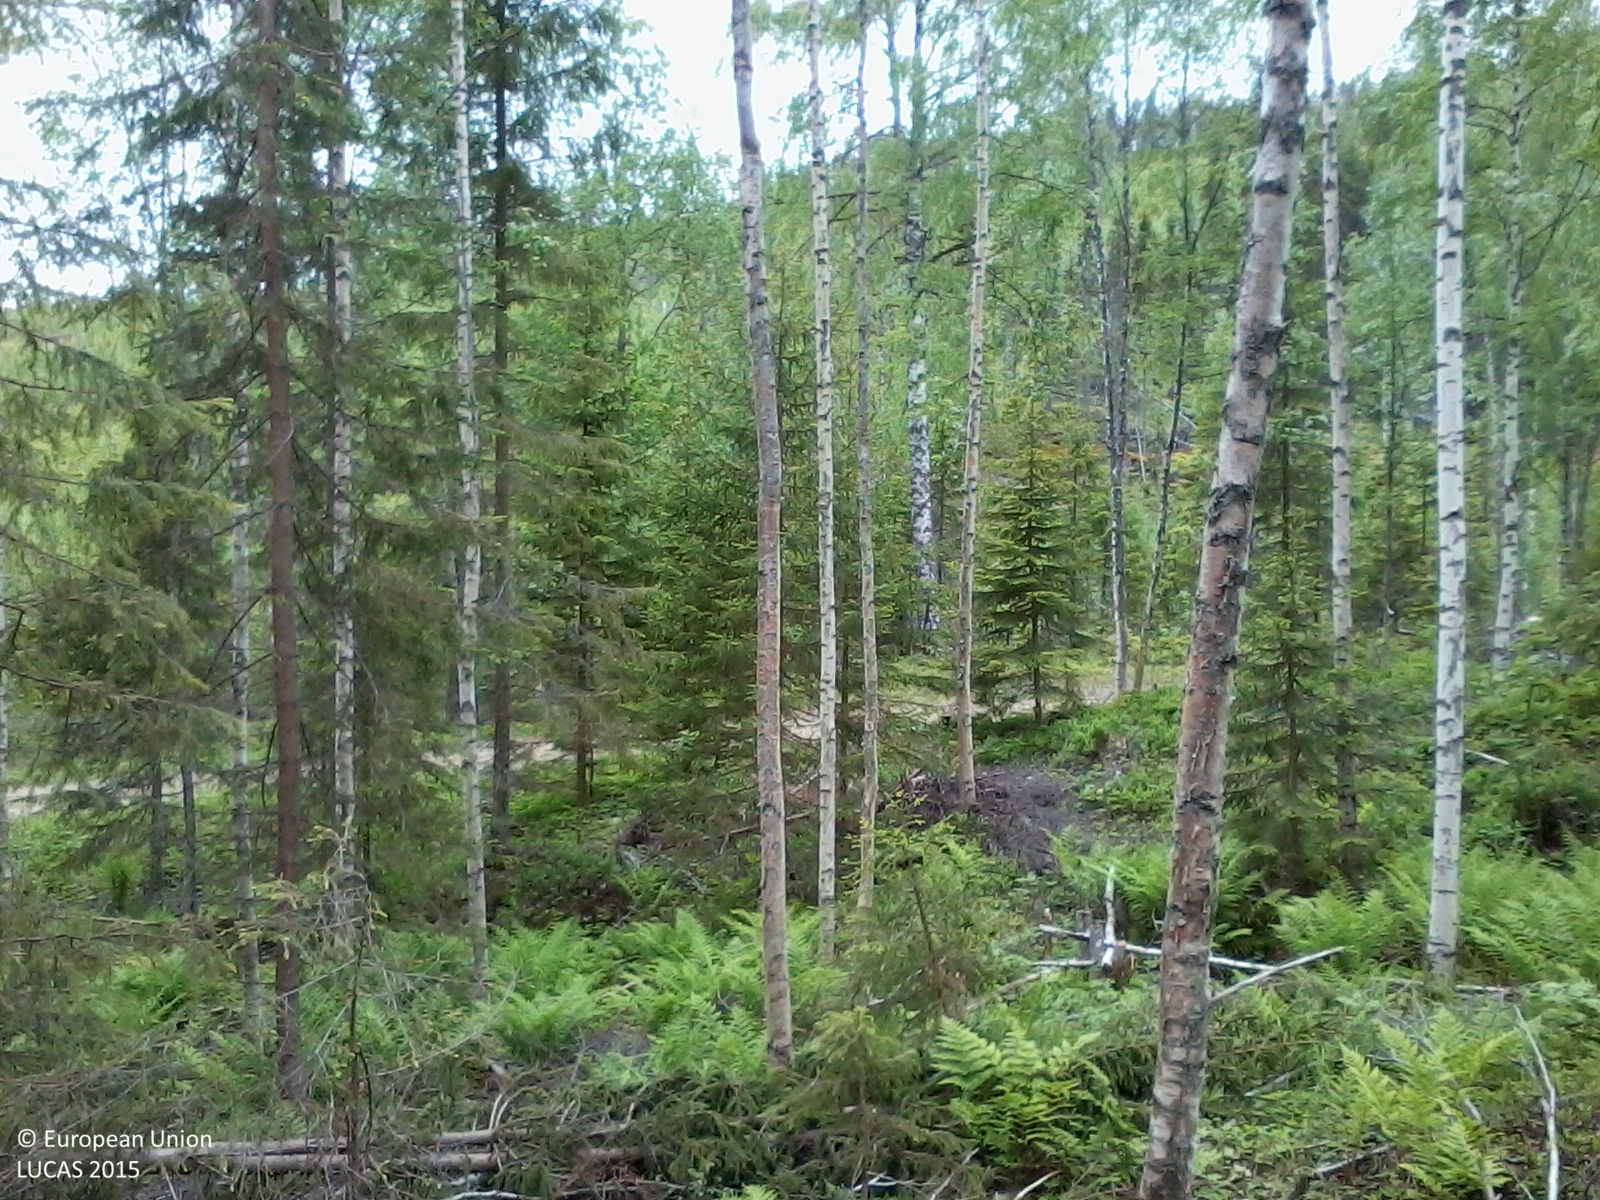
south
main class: Woodland
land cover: Spruce dominated mixed woodland
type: boreal forest
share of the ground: 50 - 75 %
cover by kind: coniferous forest trees 40 %, shrubs 25 %, broadleaved forest trees 20 %, herbaceous plants 15 %
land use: Forestry
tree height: > 5 m
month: June
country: SE
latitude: 63.4392
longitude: 17.8928
